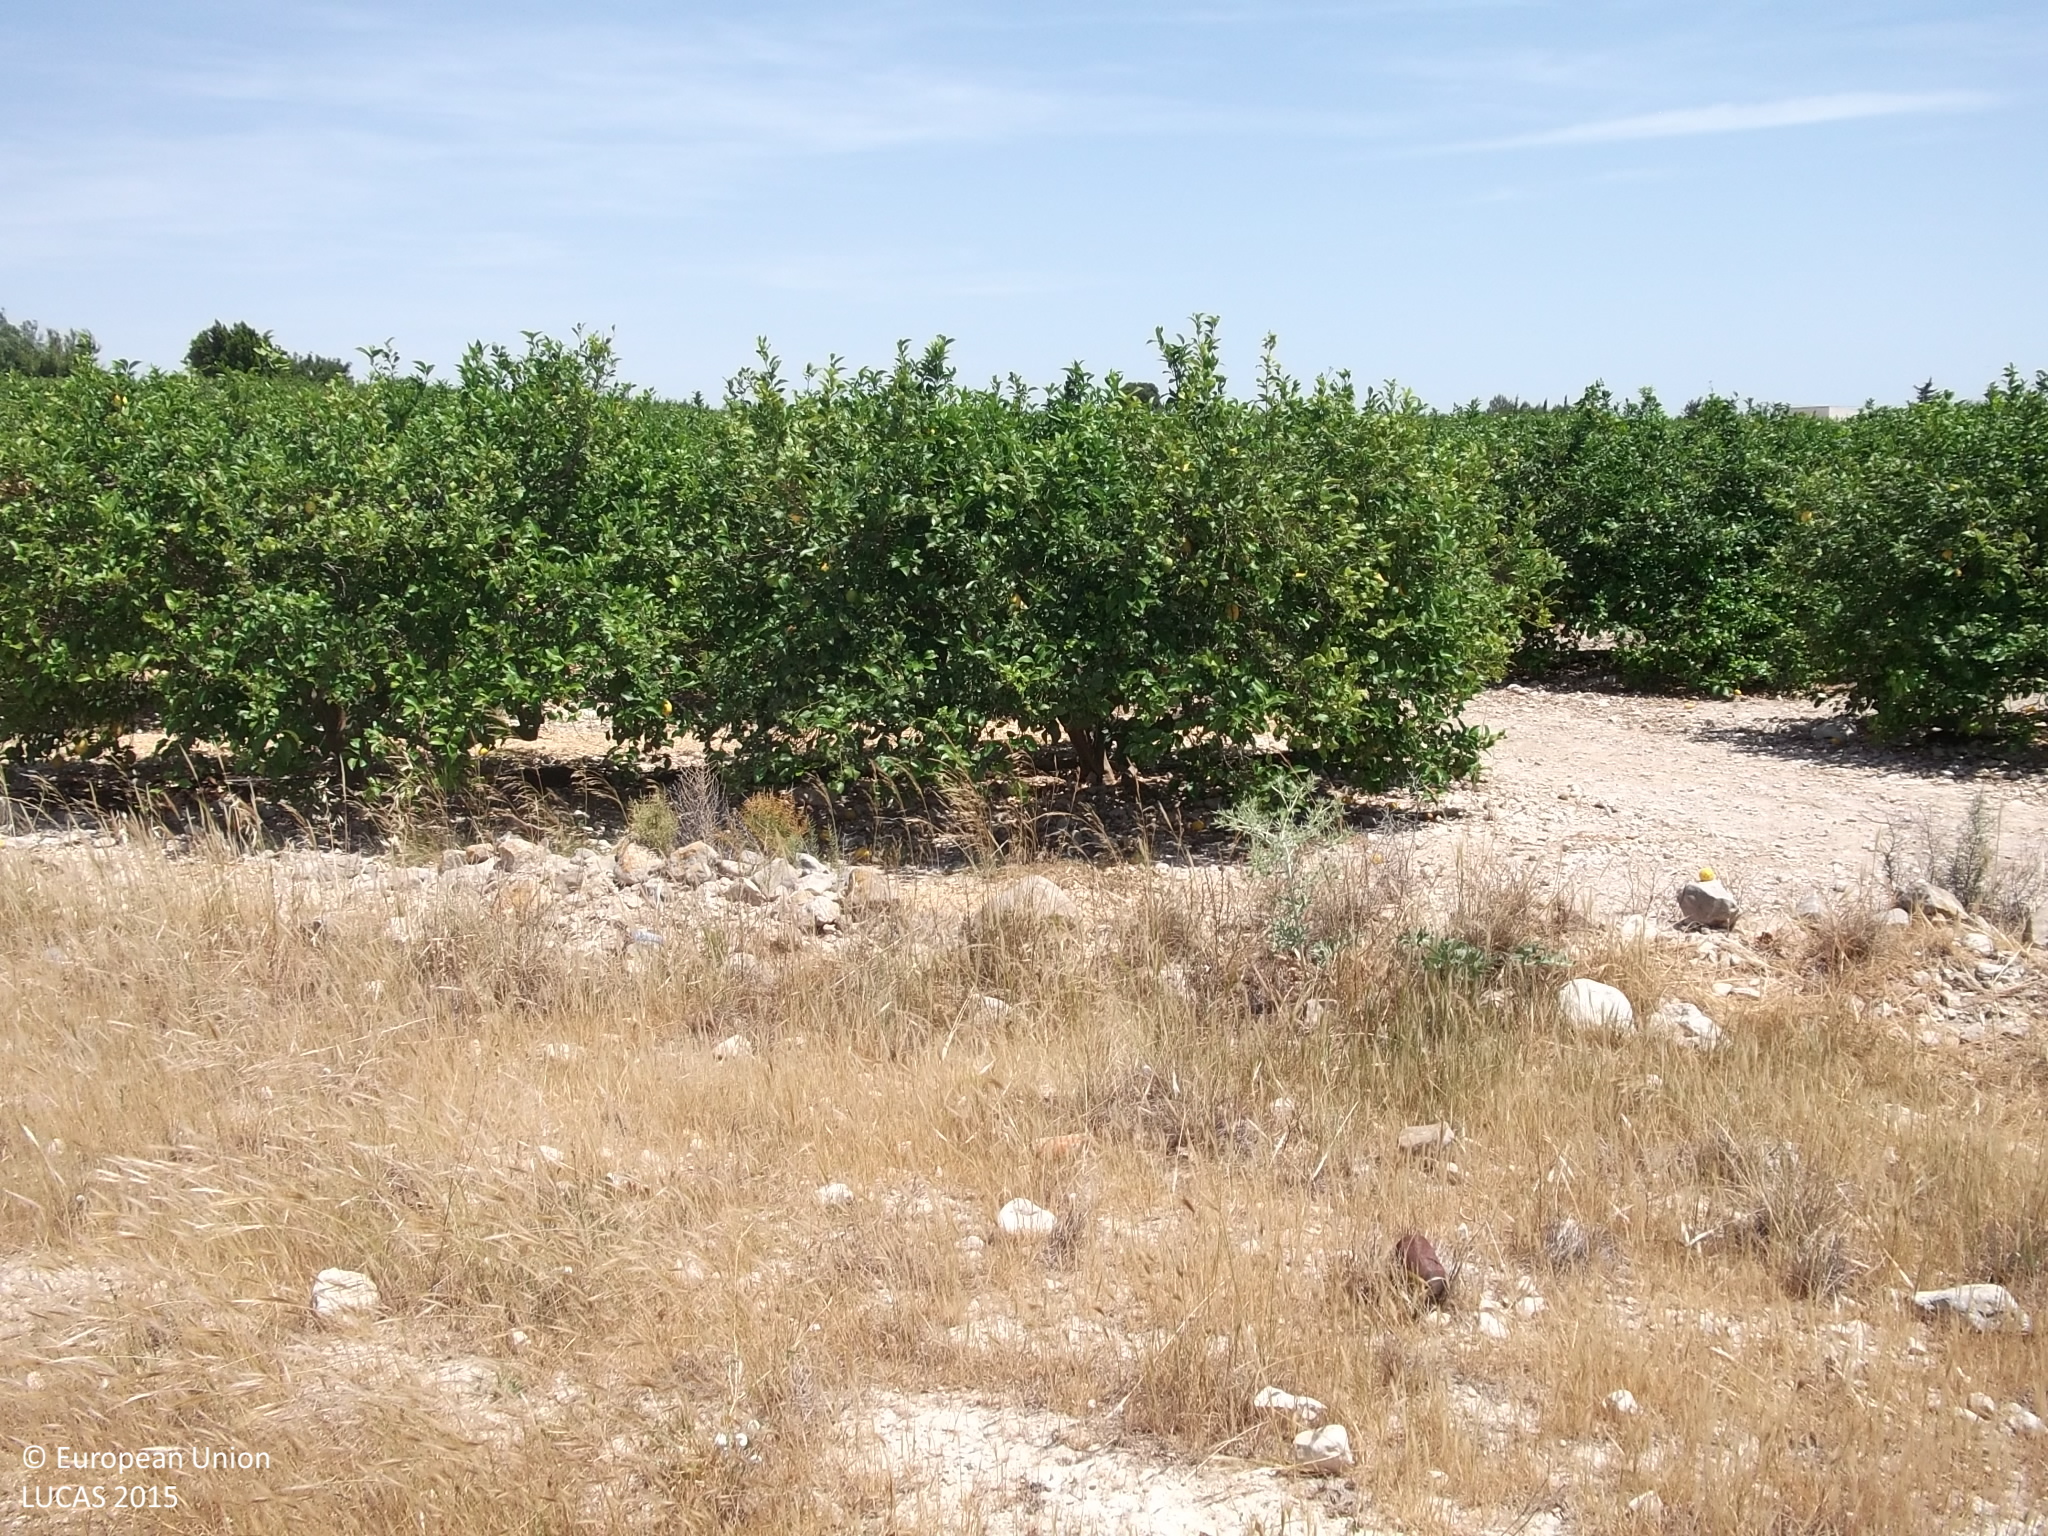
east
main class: Grassland
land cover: Grassland without tree/shrub cover
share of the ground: 10 - 25 %
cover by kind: herbaceous plants 50 %, consolidated bare surface 45 %, shrubs 5 %
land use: Abandoned areas
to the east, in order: Grassland without tree/shrub cover; Other citrus fruit; Tracks; Other citrus fruit; Paved roads, cycling and walking lanes; Grass margins; Groves; Grassland without tree/shrub cover; Rock outcrops; Other bare soil
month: May
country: ES
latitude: 38.1857
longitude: -1.0029
